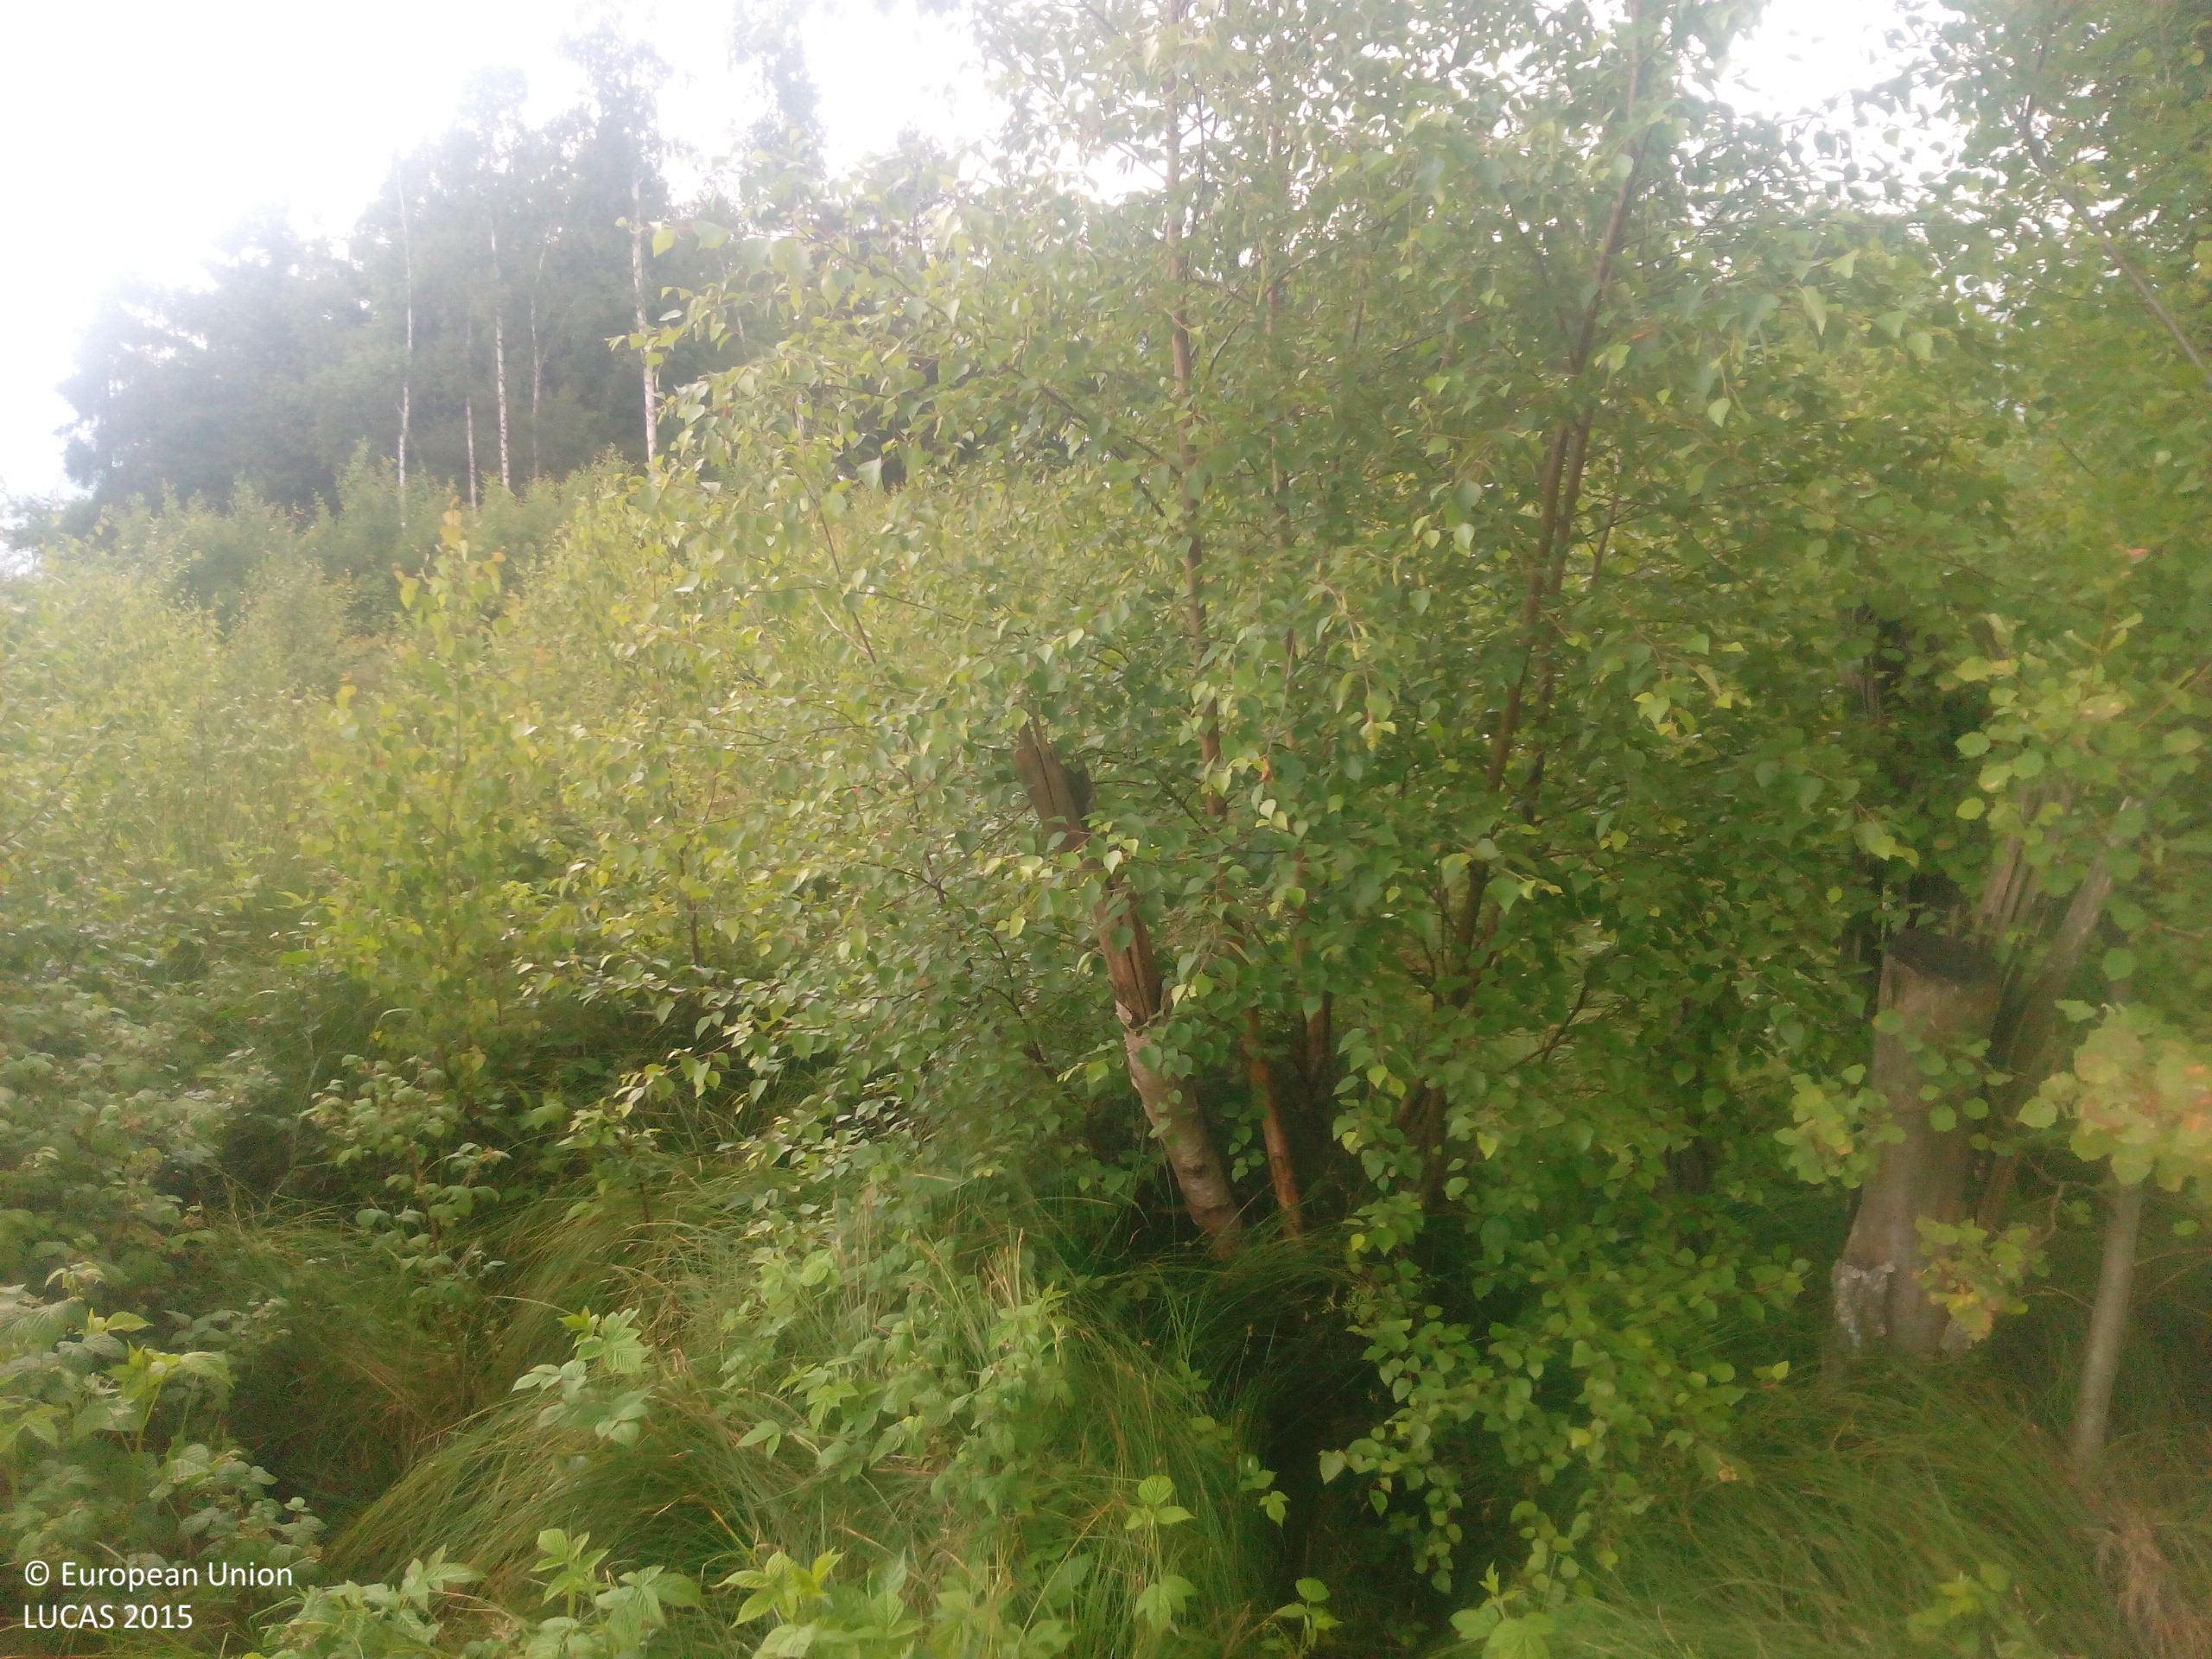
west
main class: Woodland
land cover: Broadleaved woodland
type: acidophilous oak and oak-birch forest
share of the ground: 25 - 50 %
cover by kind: broadleaved forest trees 50 %, shrubs 30 %, herbaceous plants 20 %
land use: Forestry
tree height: < 5 m
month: June
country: DE
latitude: 51.1227
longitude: 13.9872
